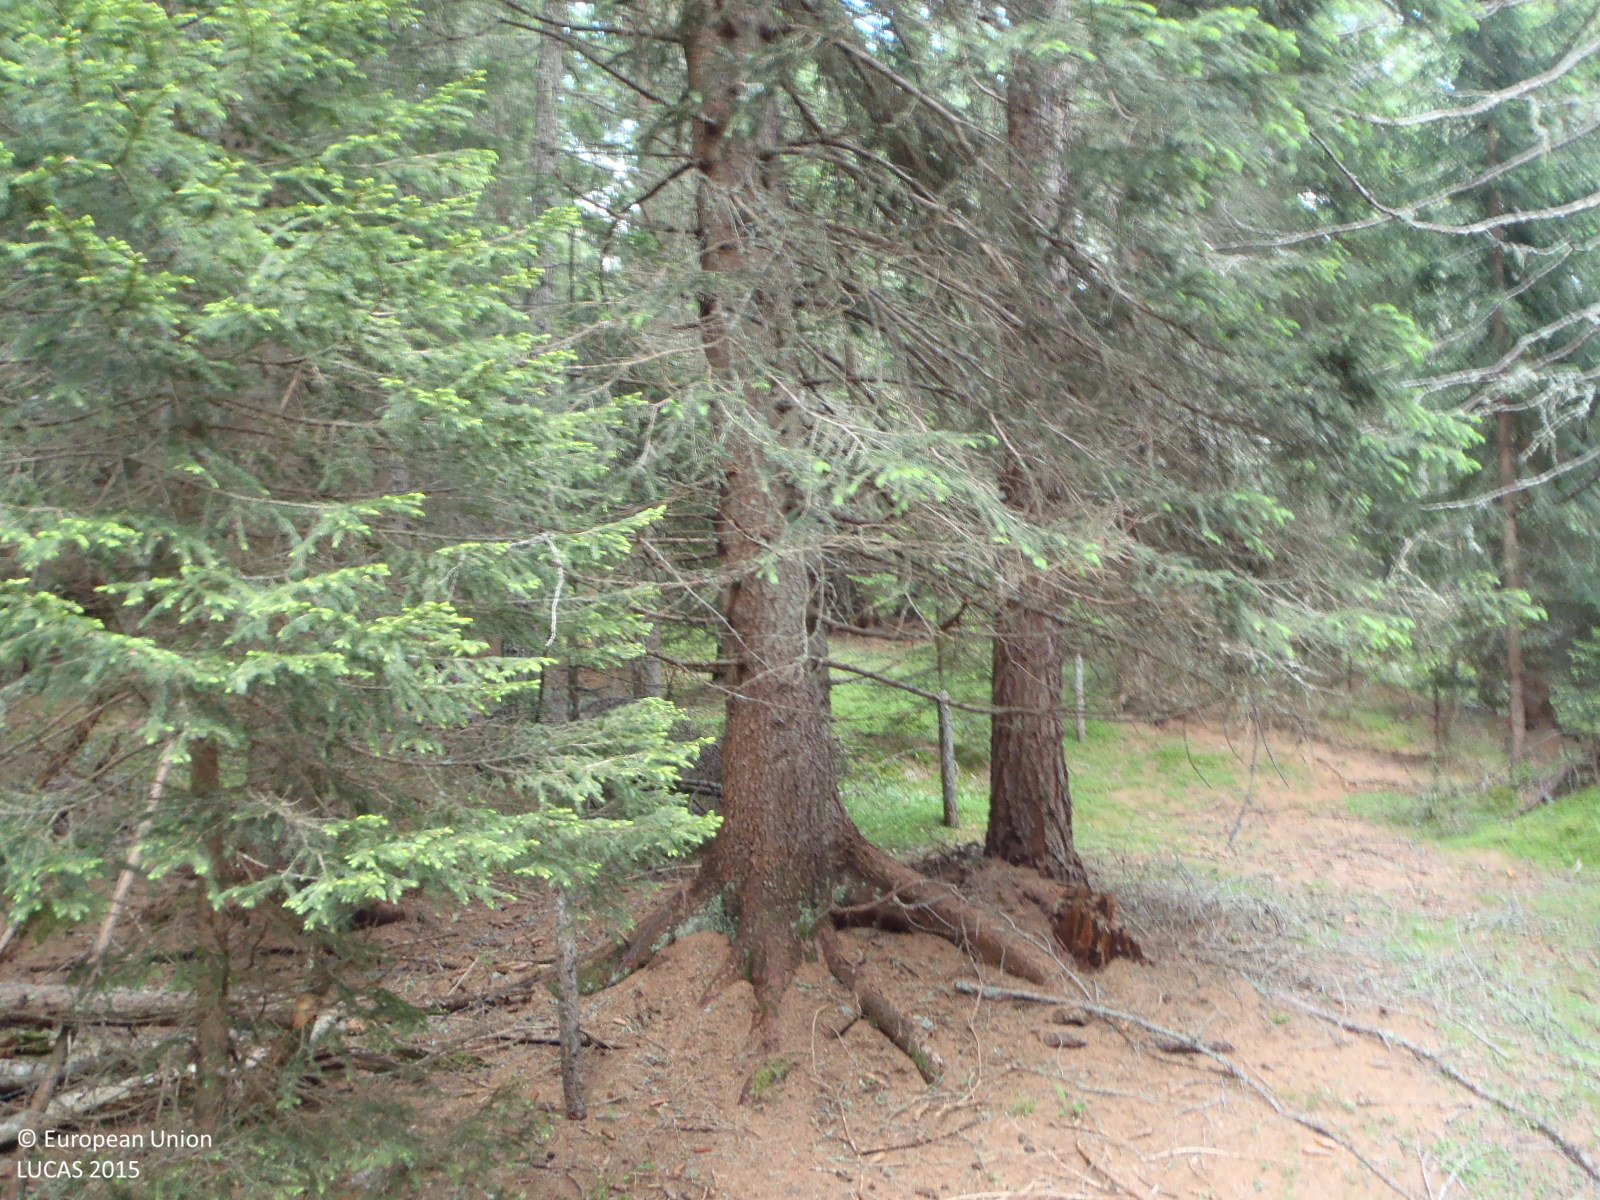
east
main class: Woodland
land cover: Other coniferous woodland
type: alpine coniferous forest
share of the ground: > 75 %
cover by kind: coniferous forest trees 100 %
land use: Forestry
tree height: > 5 m
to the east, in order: Other coniferous woodland; Fences; Other coniferous woodland; Spruce dominated coniferous woodland; Other coniferous woodland; Spruce dominated coniferous woodland; Spruce dominated mixed woodland
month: June
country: AT
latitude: 47.1071
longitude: 13.9645
